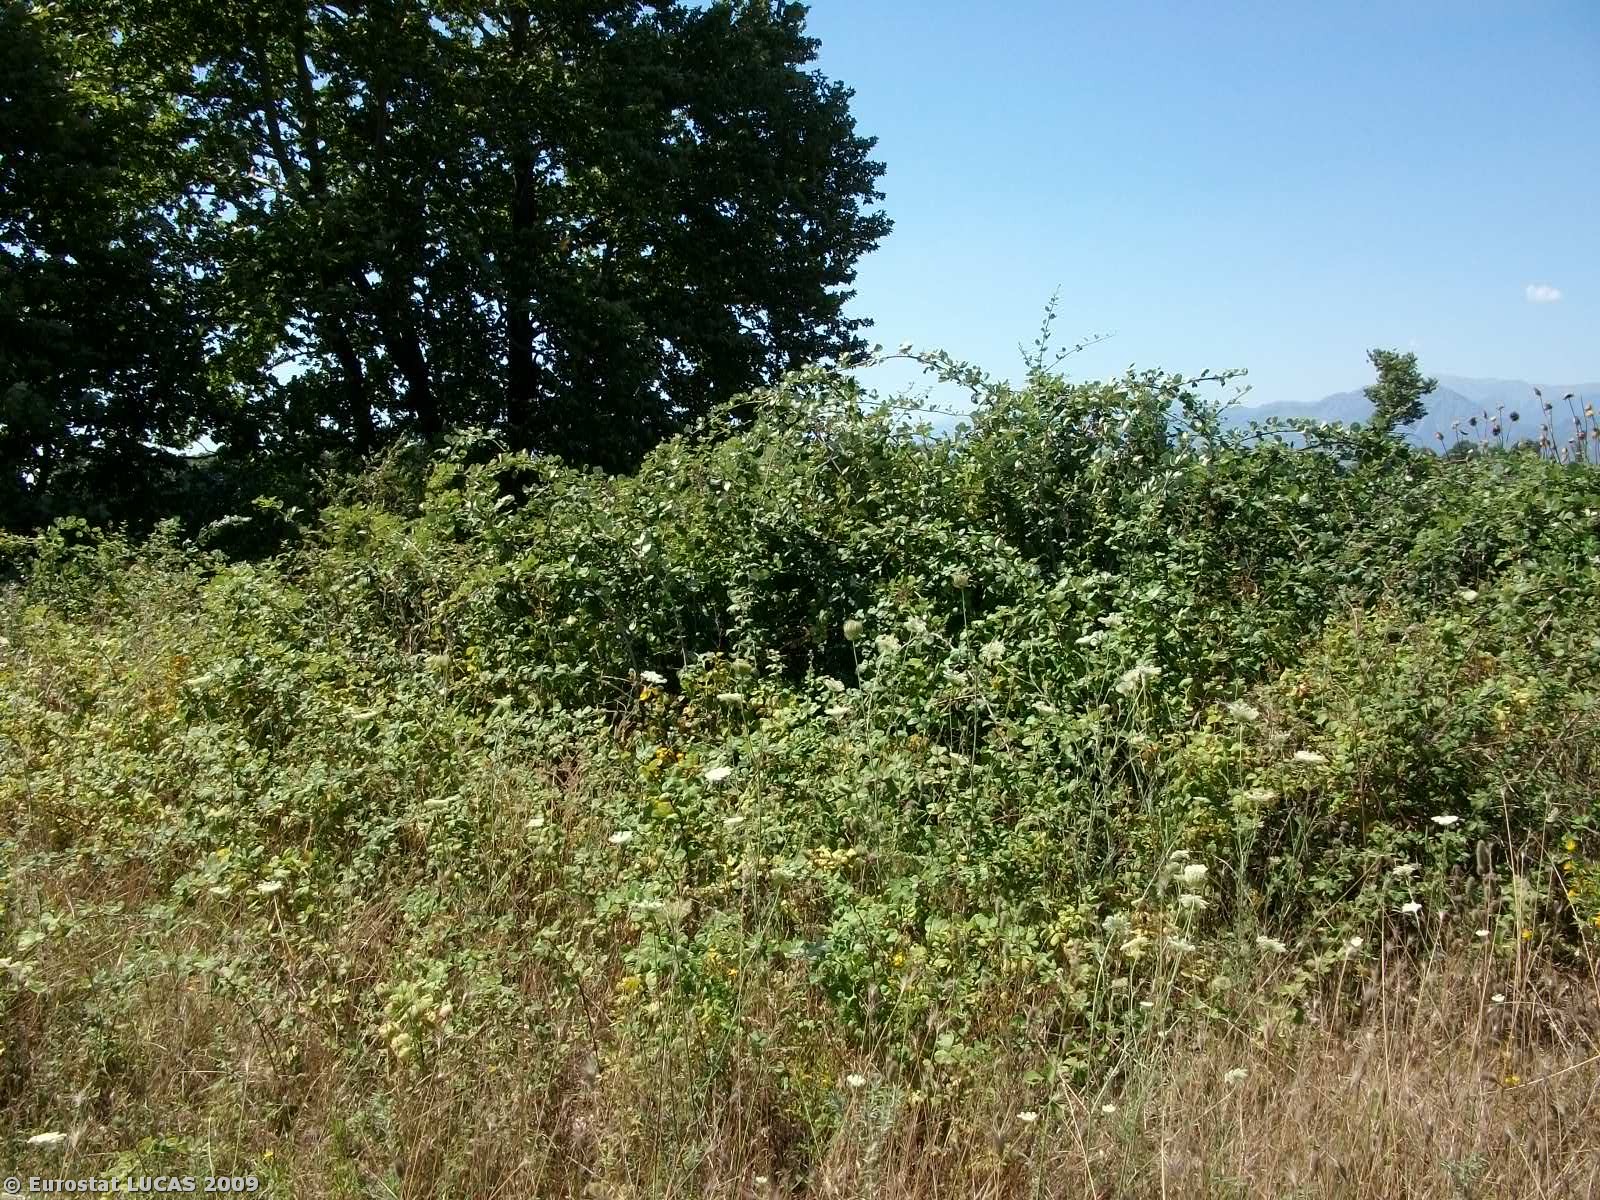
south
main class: Grassland
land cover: Grassland without tree/shrub cover
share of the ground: > 75 %
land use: Fallow land
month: July
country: GR
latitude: 39.5877
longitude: 21.6614
